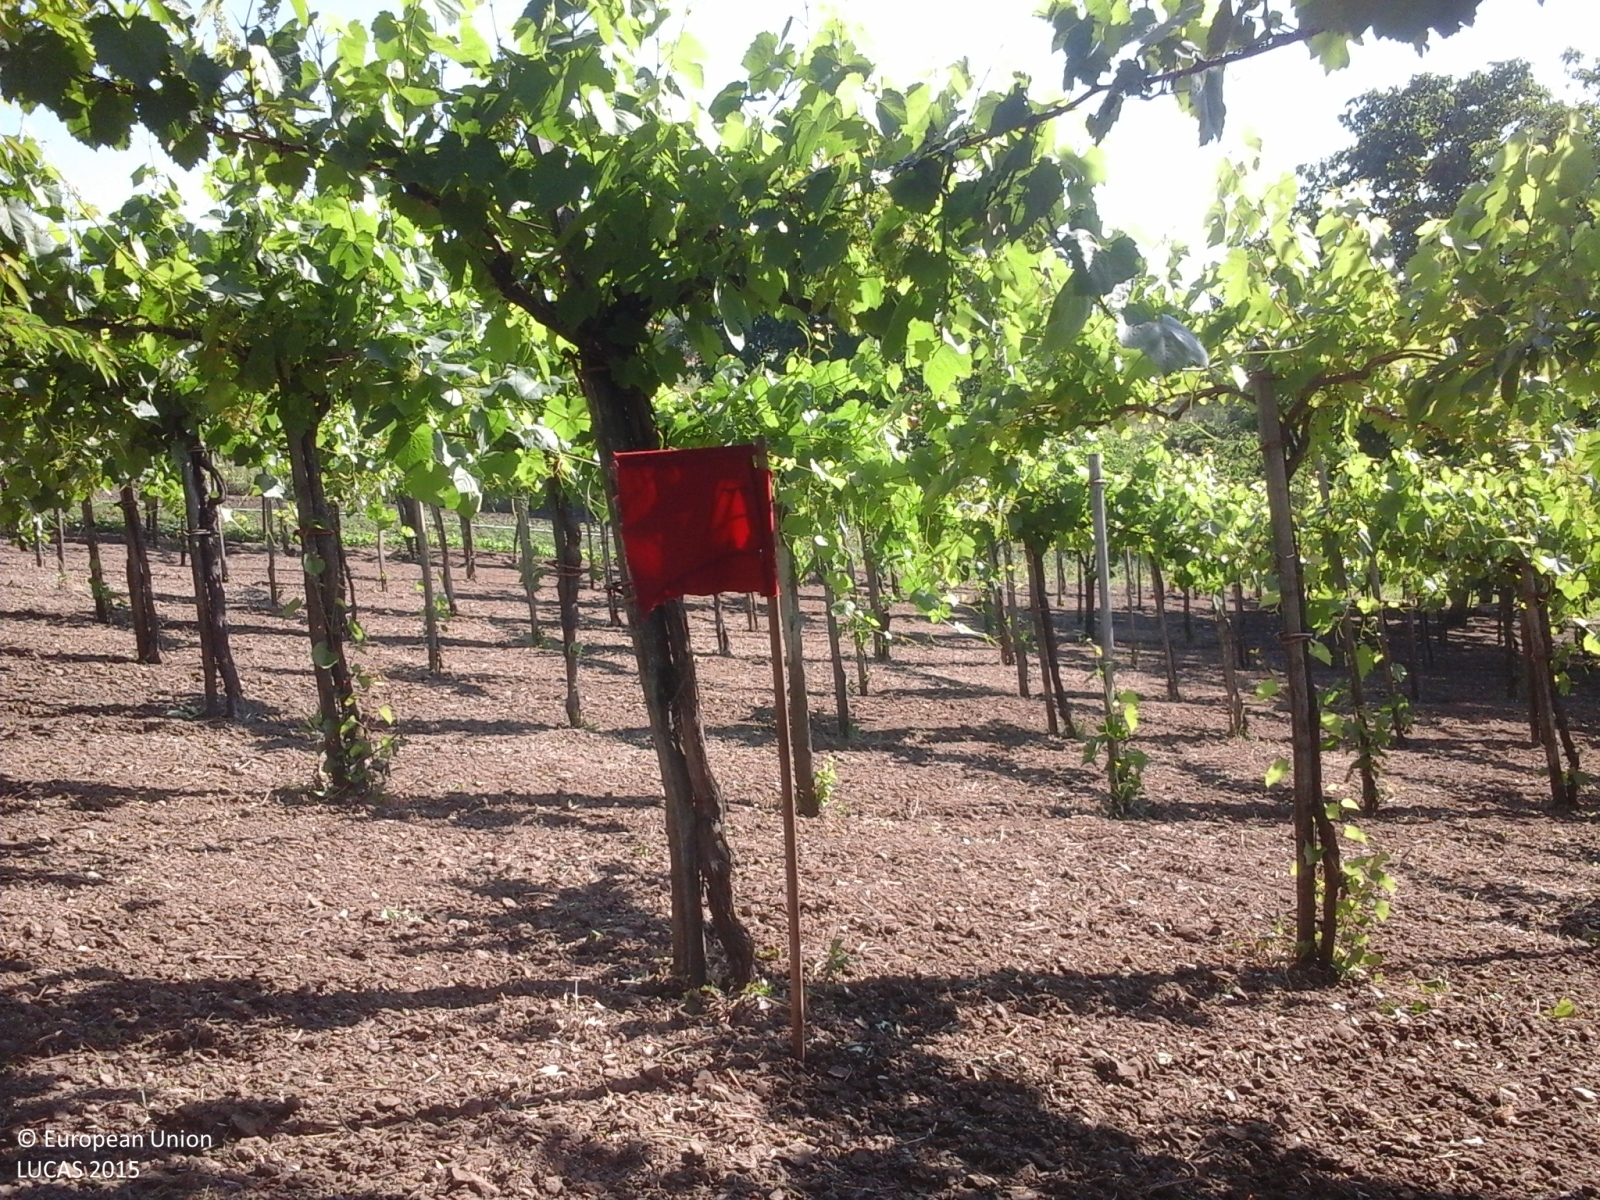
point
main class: Cropland
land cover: Vineyards
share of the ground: > 75 %
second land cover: Other bare soil
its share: > 75 %
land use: Agriculture (excluding fallow land and kitchen gardens)
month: June
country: IT
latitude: 41.1698
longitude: 14.6903
